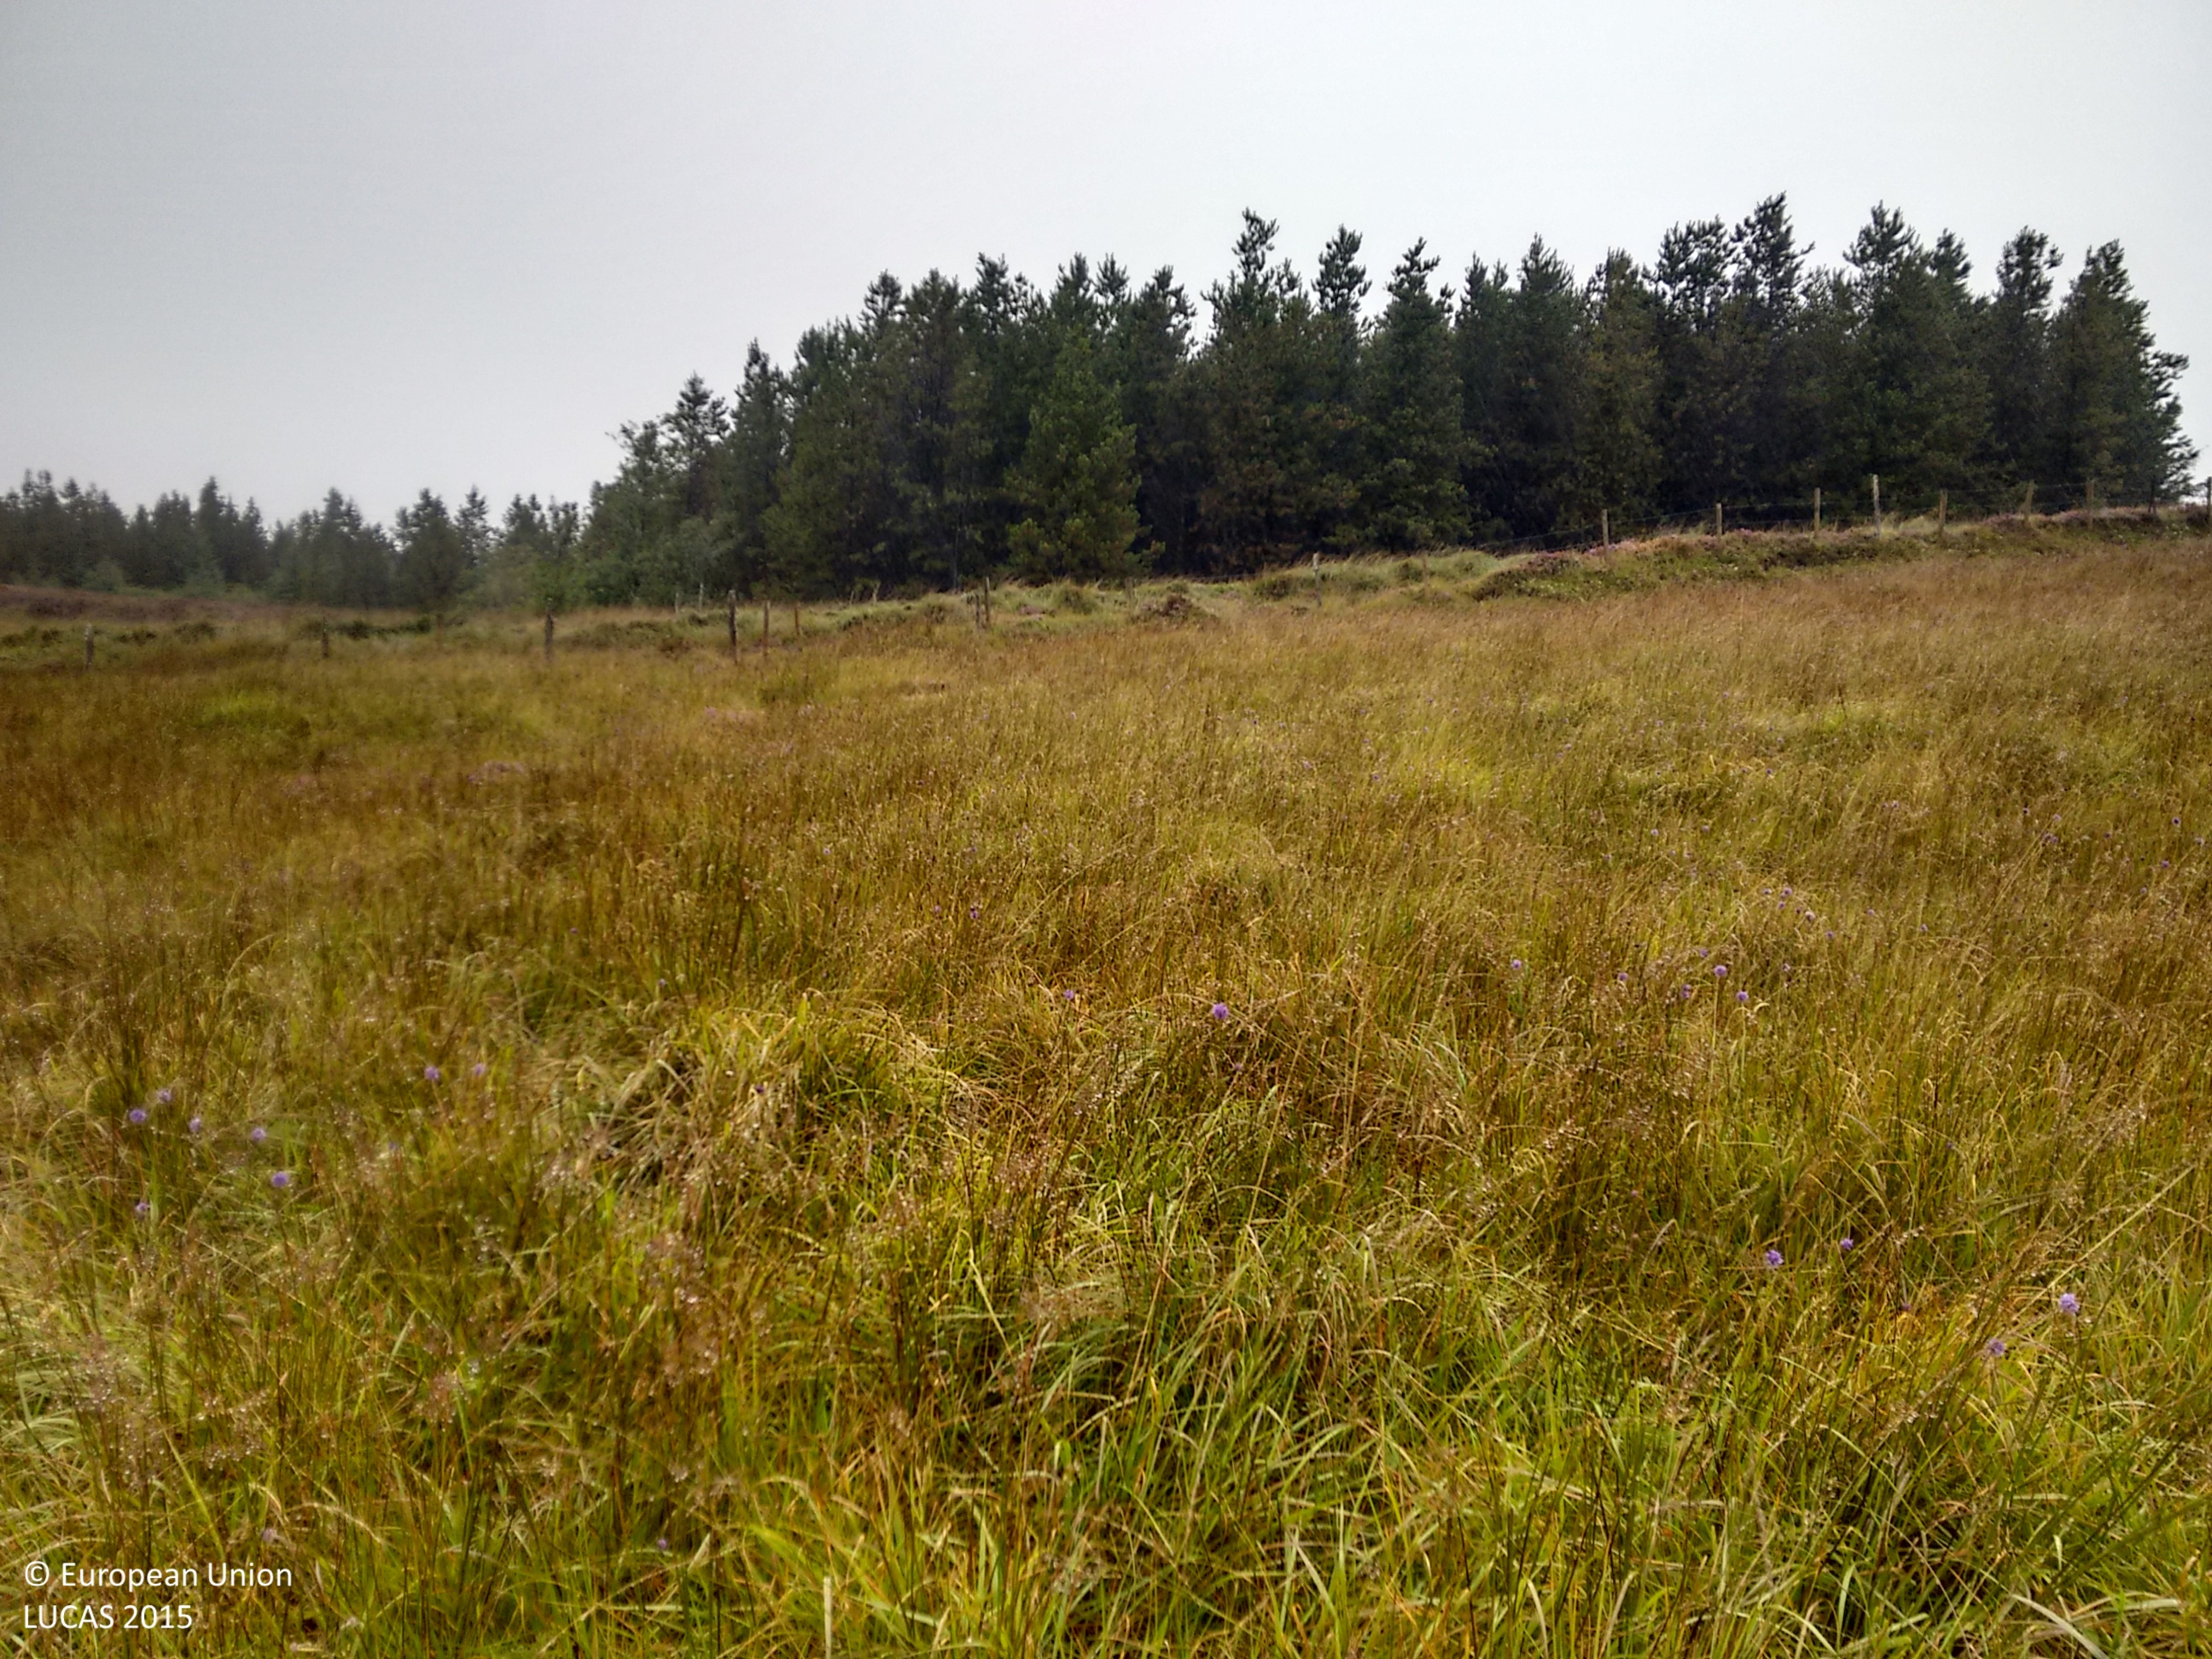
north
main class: Grassland
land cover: Grassland without tree/shrub cover
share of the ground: > 75 %
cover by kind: herbaceous plants 100 %
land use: Agriculture (excluding fallow land and kitchen gardens)
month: September
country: IE
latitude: 52.7387
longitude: -8.7007
